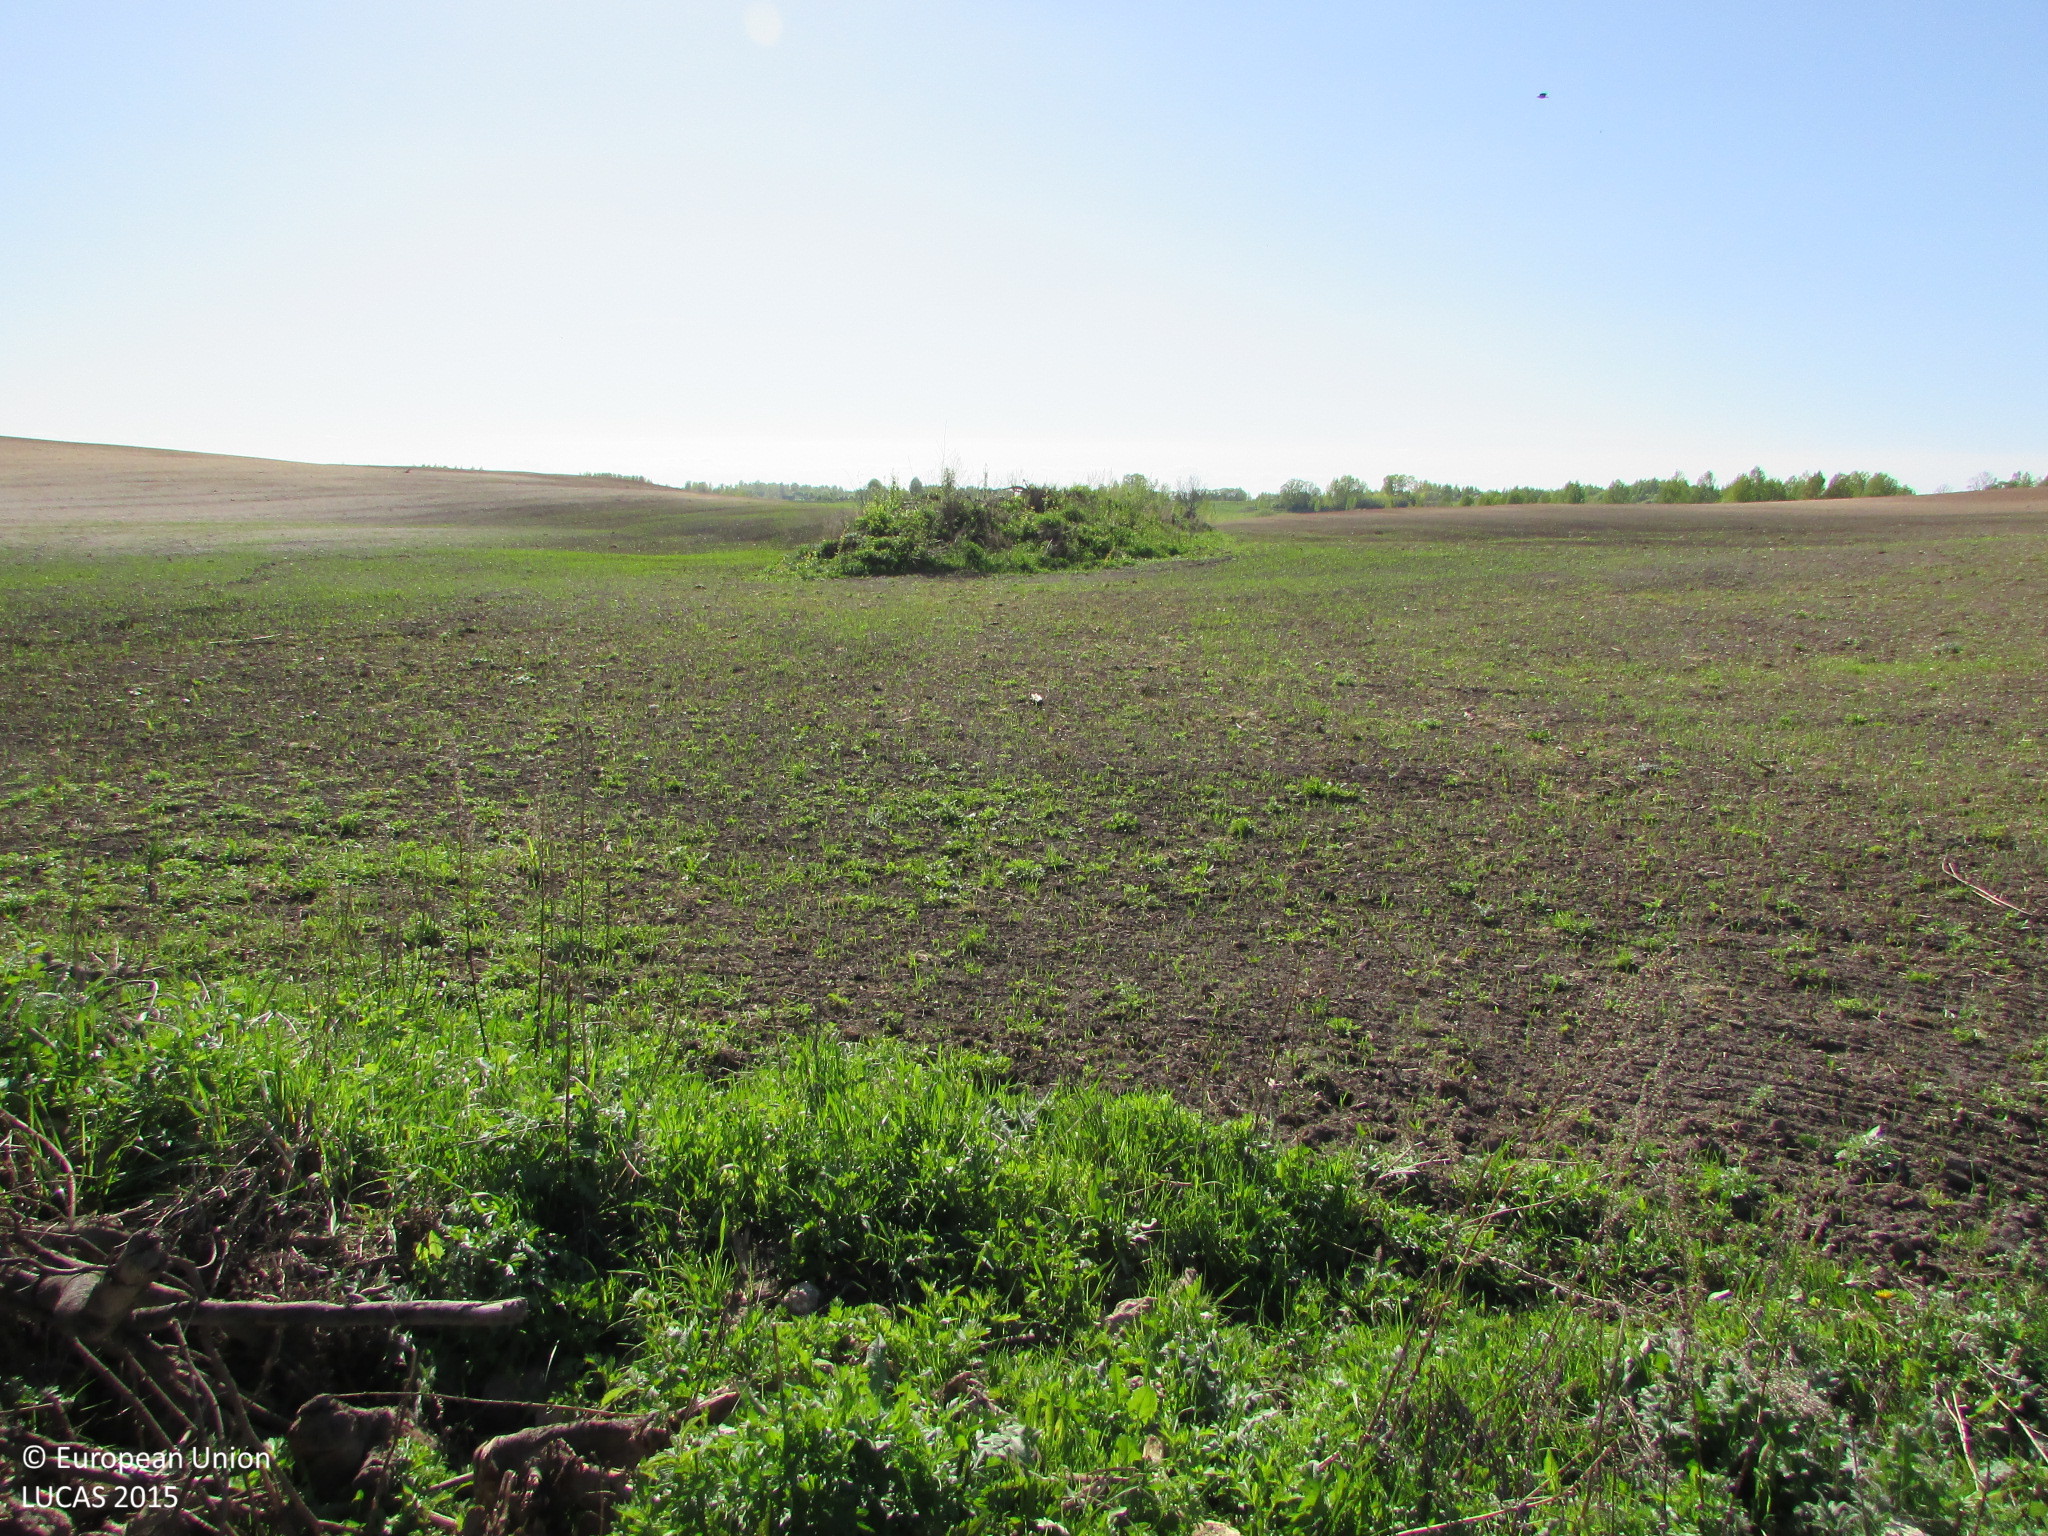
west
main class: Grassland
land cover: Spontaneously vegetated surfaces
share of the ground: 50 - 75 %
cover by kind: herbaceous plants 60 %, shrubs 5 %
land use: Semi-natural and natural areas not in use
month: May
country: LV
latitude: 55.8541
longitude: 27.5151
